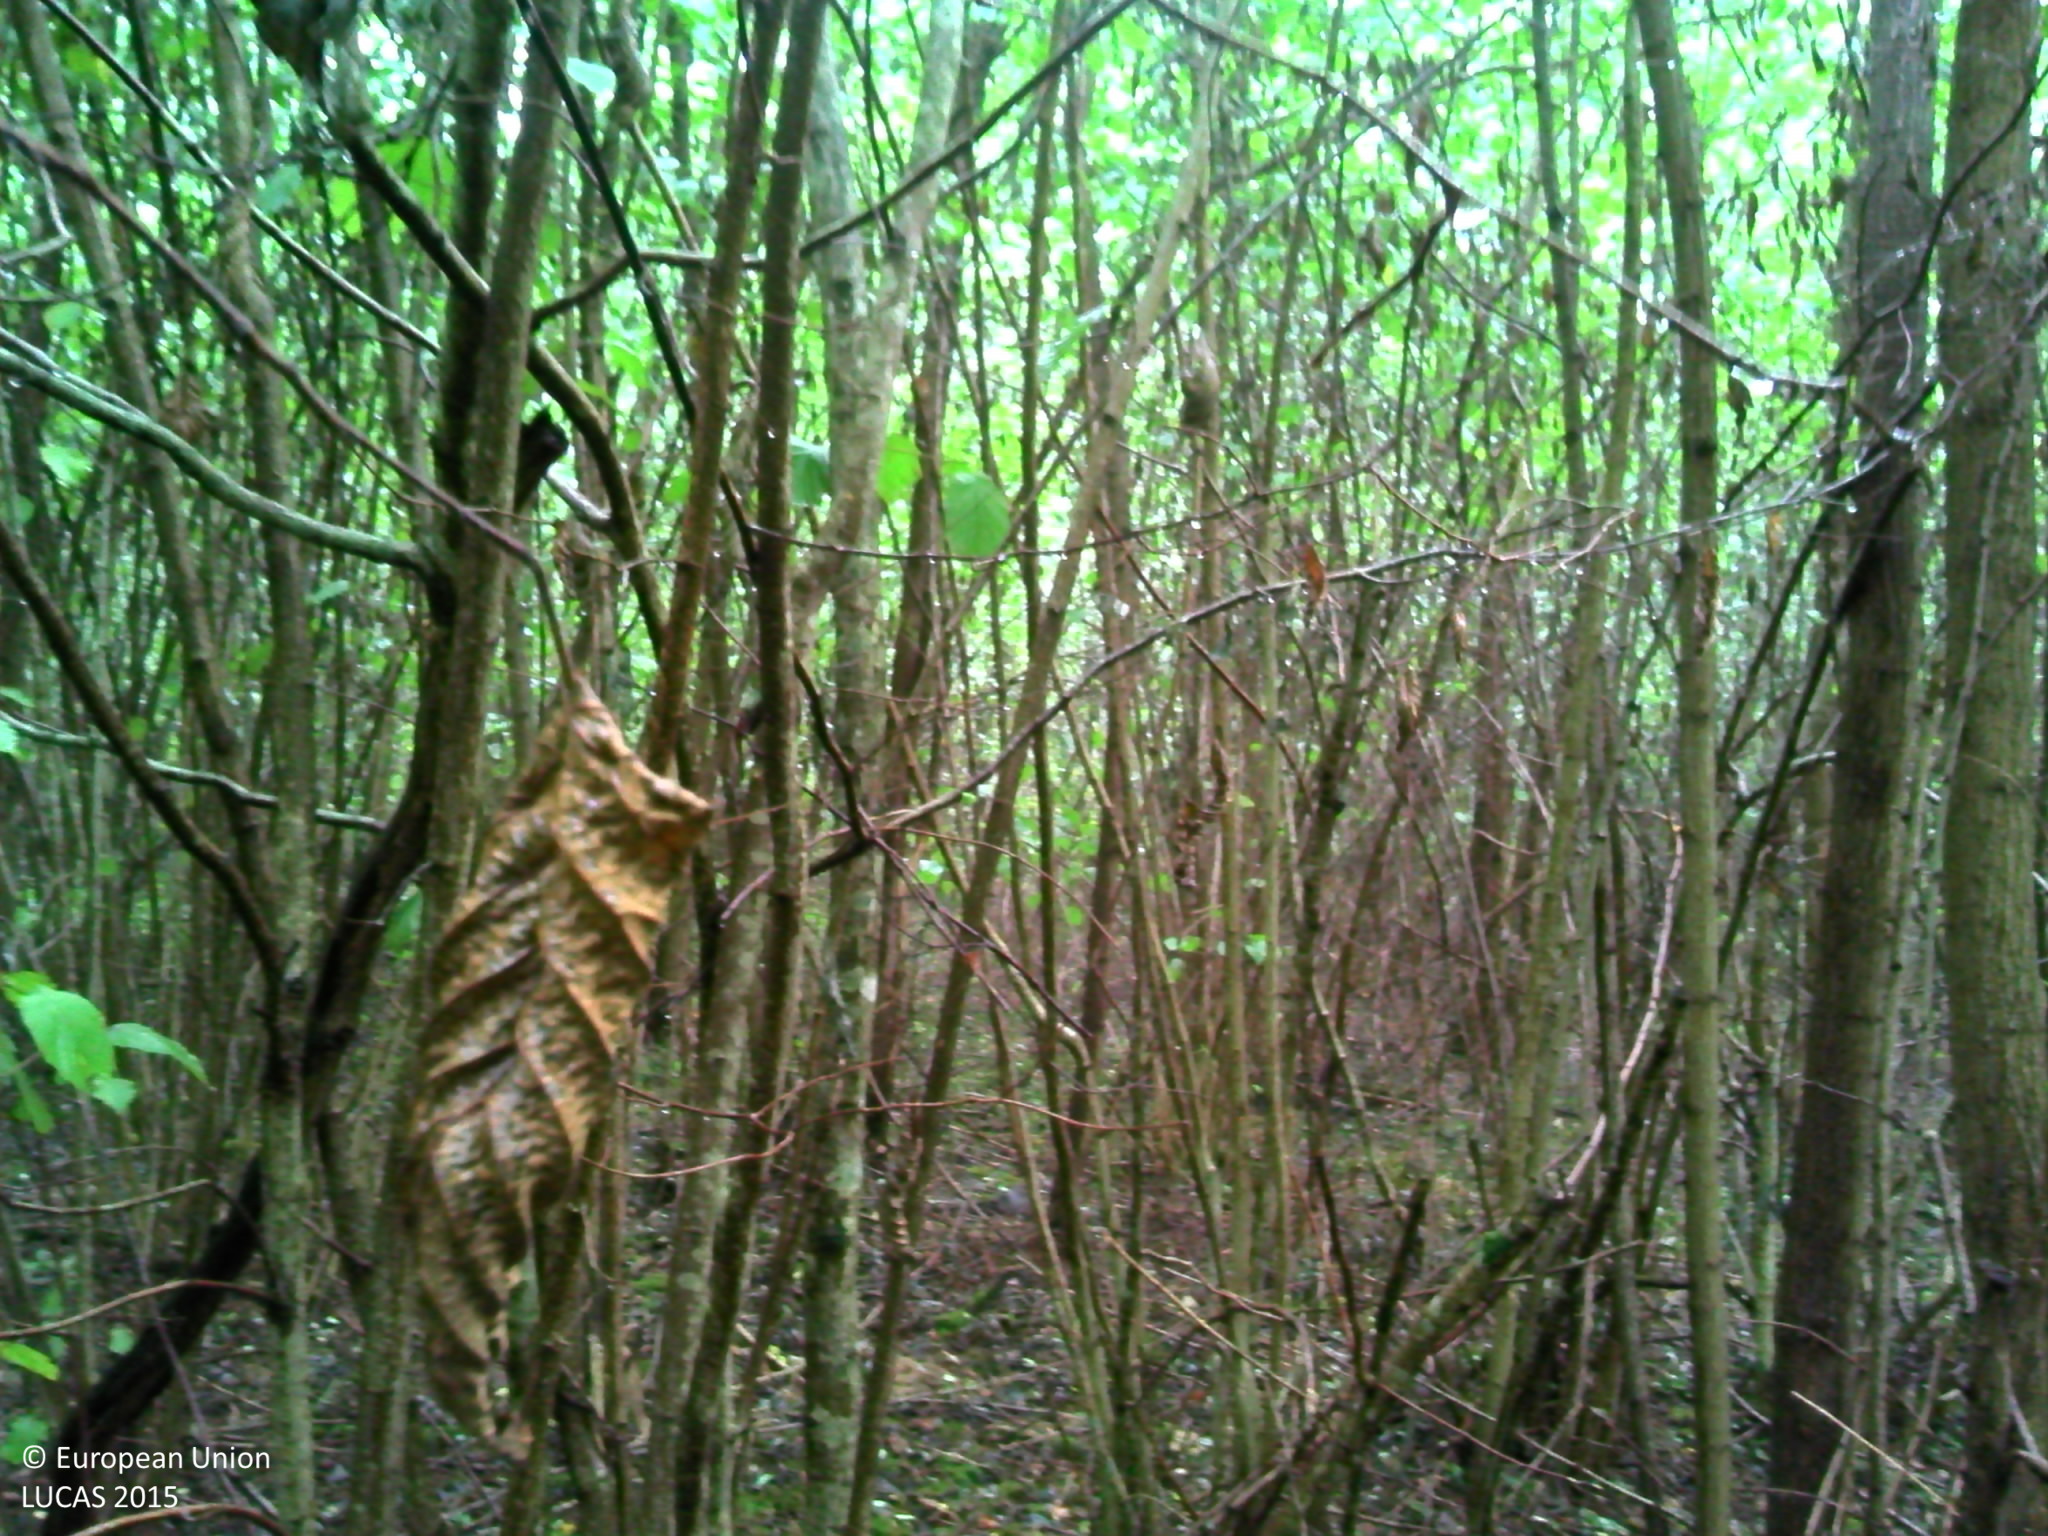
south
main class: Woodland
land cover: Broadleaved woodland
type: mesophytic deciduous forest
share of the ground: > 75 %
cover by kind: broadleaved forest trees 95 %, herbaceous plants 5 %
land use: Semi-natural and natural areas not in use
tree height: > 5 m
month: October
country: FR
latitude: 46.4396
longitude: 5.1475
